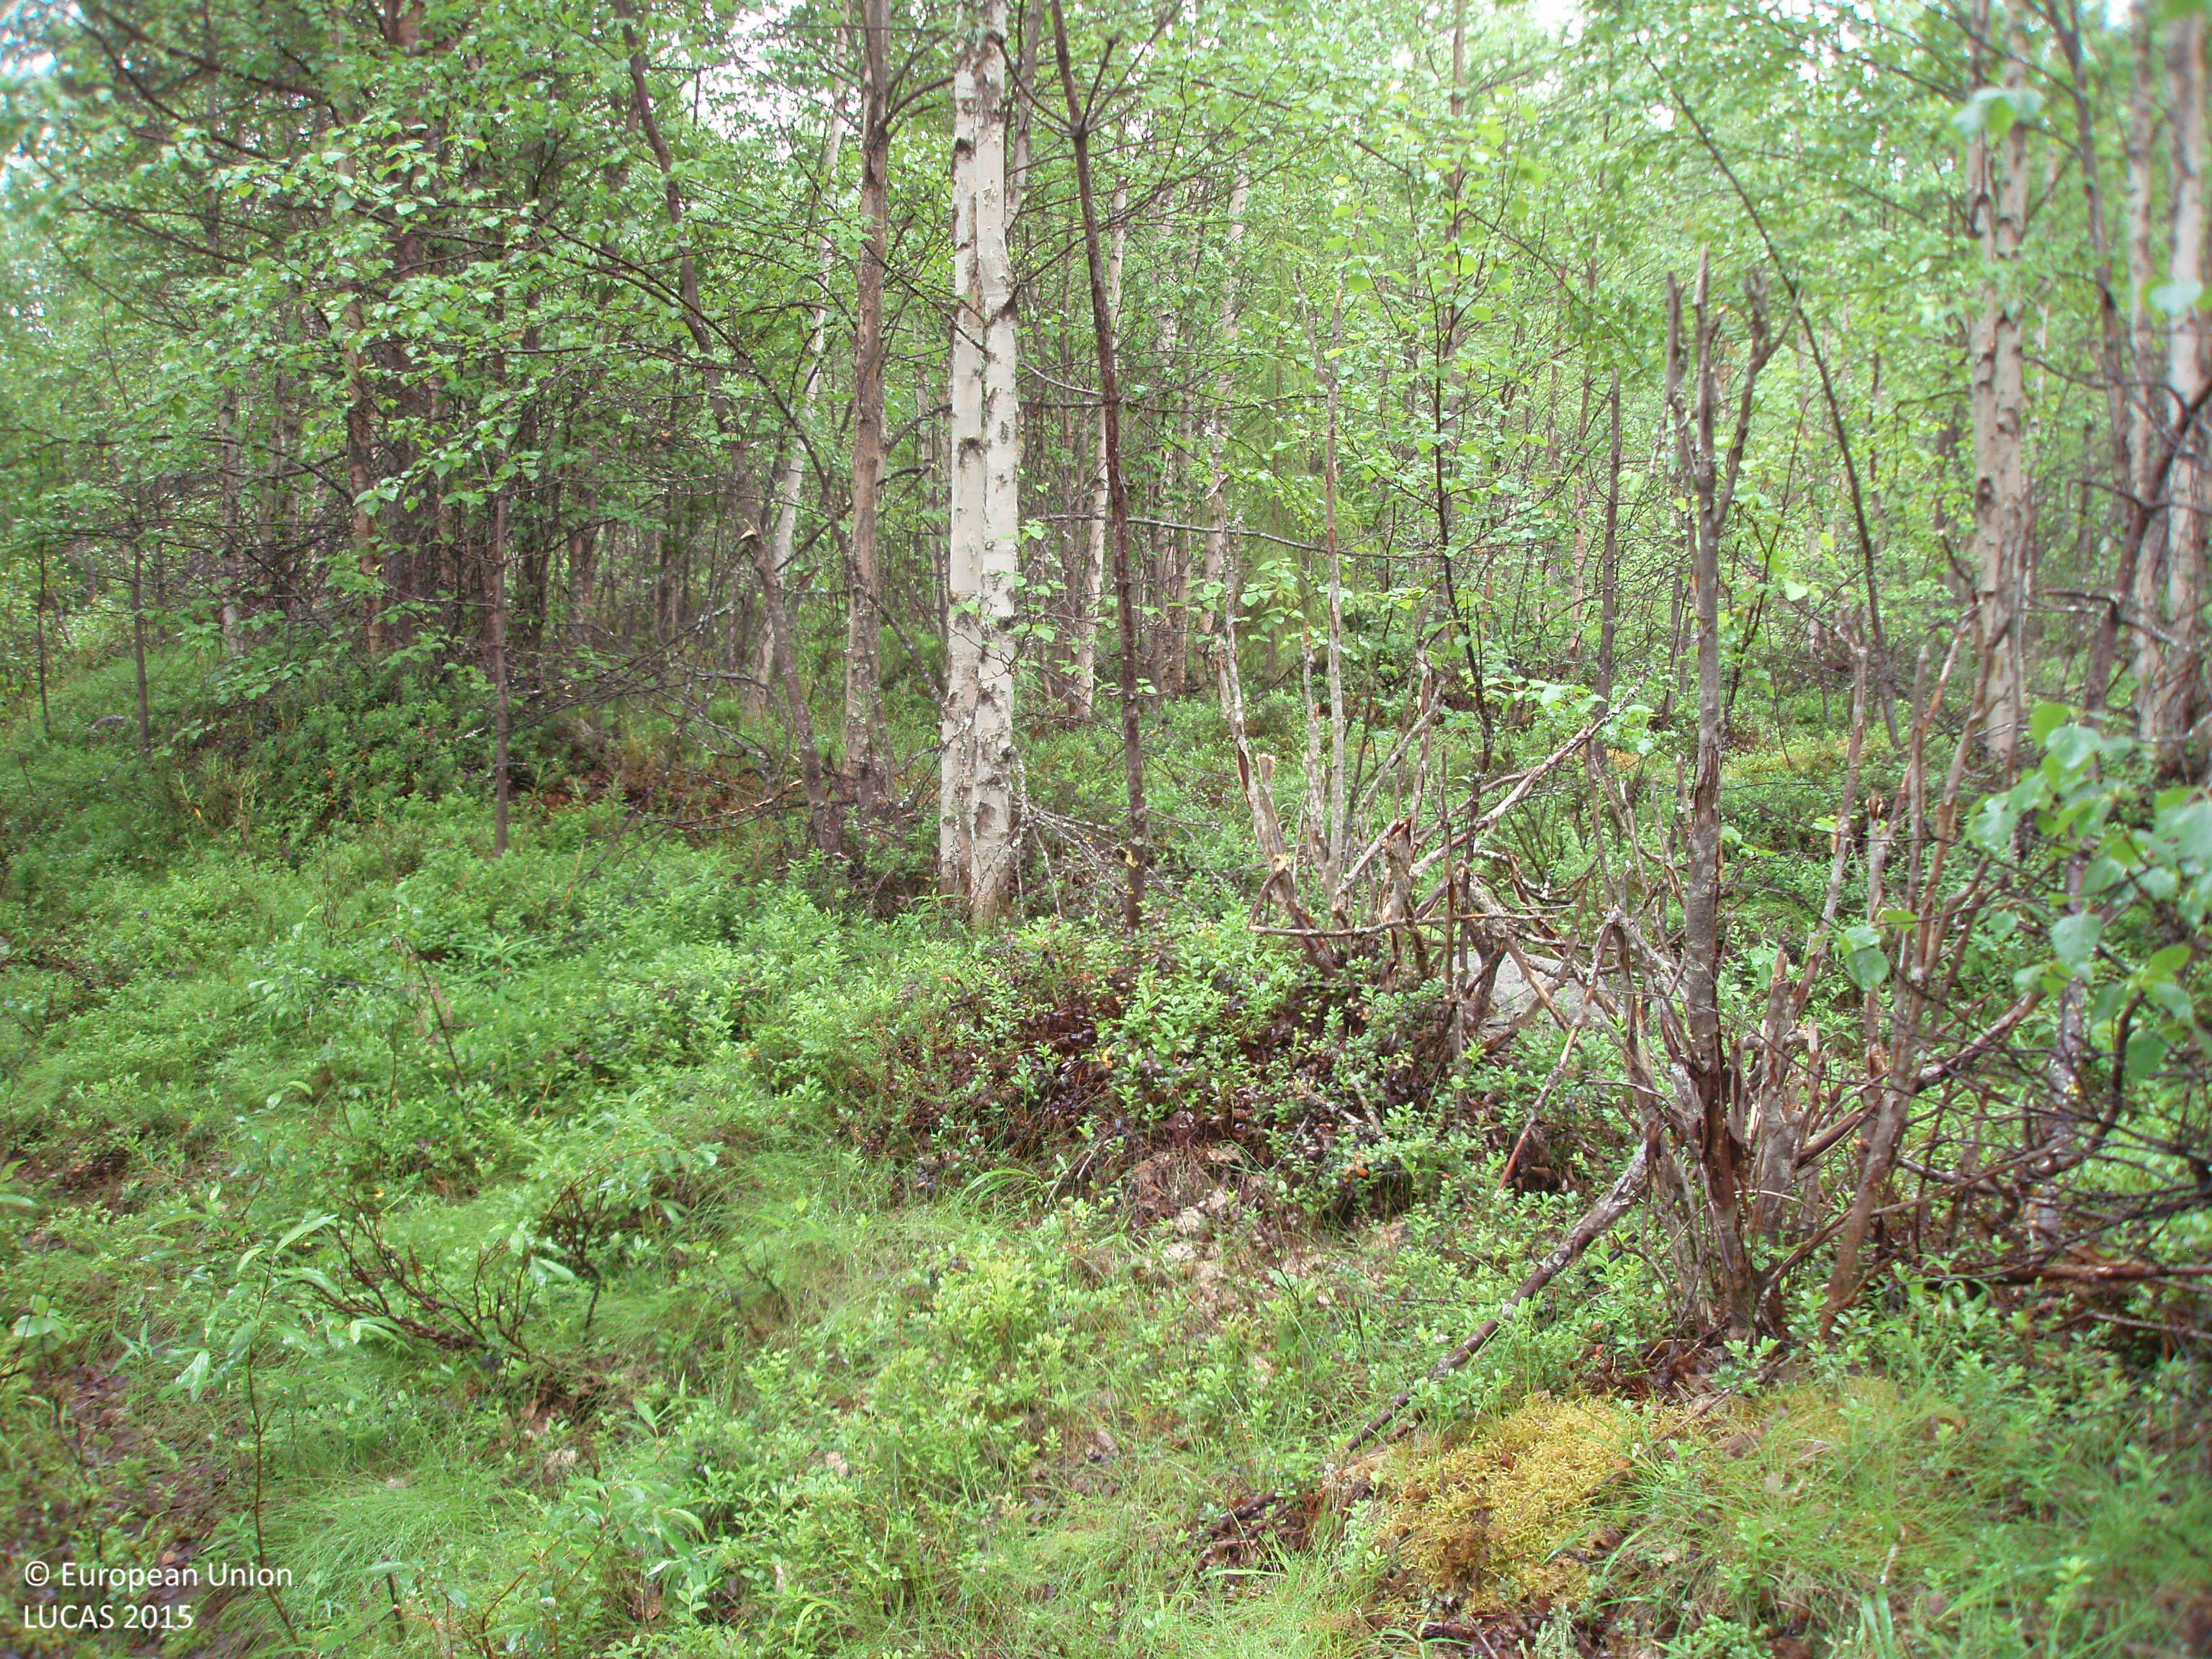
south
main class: Woodland
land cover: Pine dominated mixed woodland
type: boreal forest
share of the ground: > 75 %
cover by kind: broadleaved forest trees 50 %, coniferous forest trees 40 %, shrubs 10 %
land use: Forestry
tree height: > 5 m
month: July
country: FI
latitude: 66.8000
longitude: 28.2630
